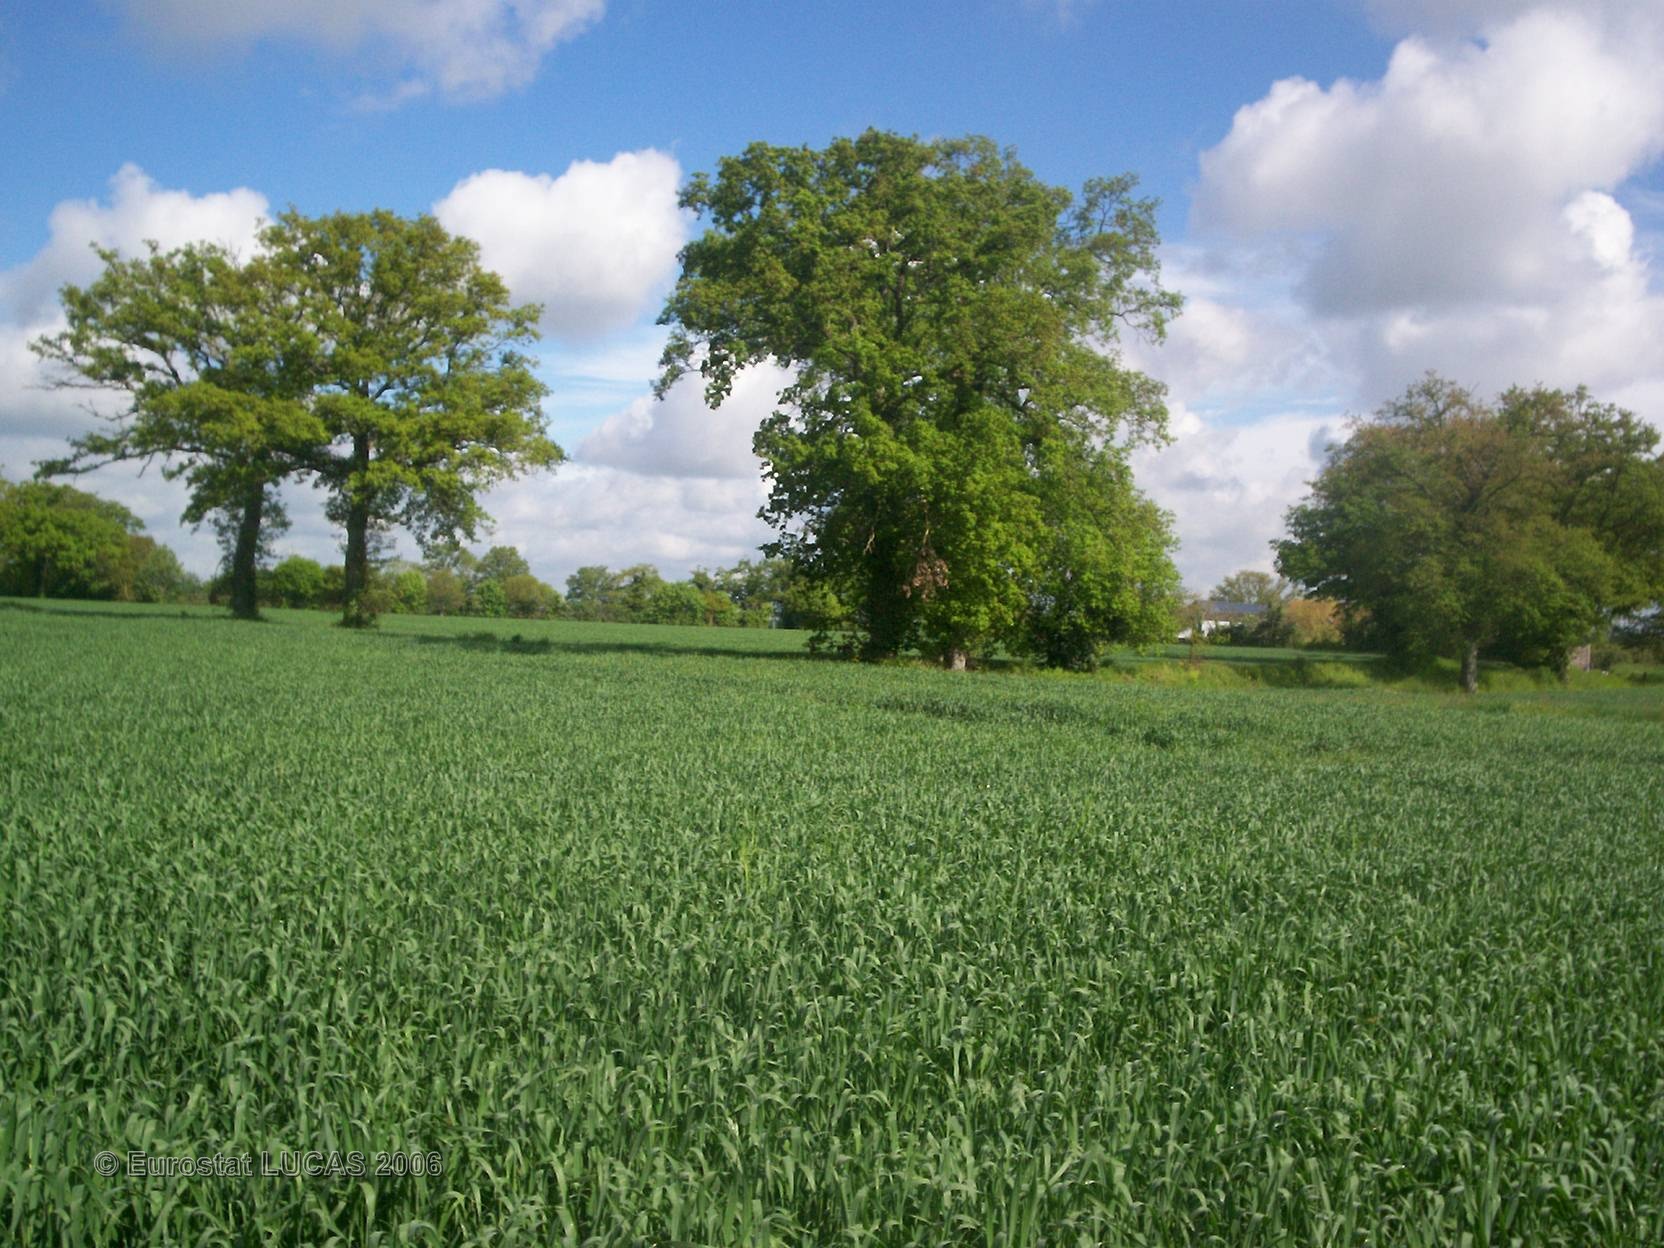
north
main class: Cropland
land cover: Common wheat
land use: Agriculture (excluding fallow land and kitchen gardens)
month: May
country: FR
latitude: 48.0538
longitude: -0.6203
